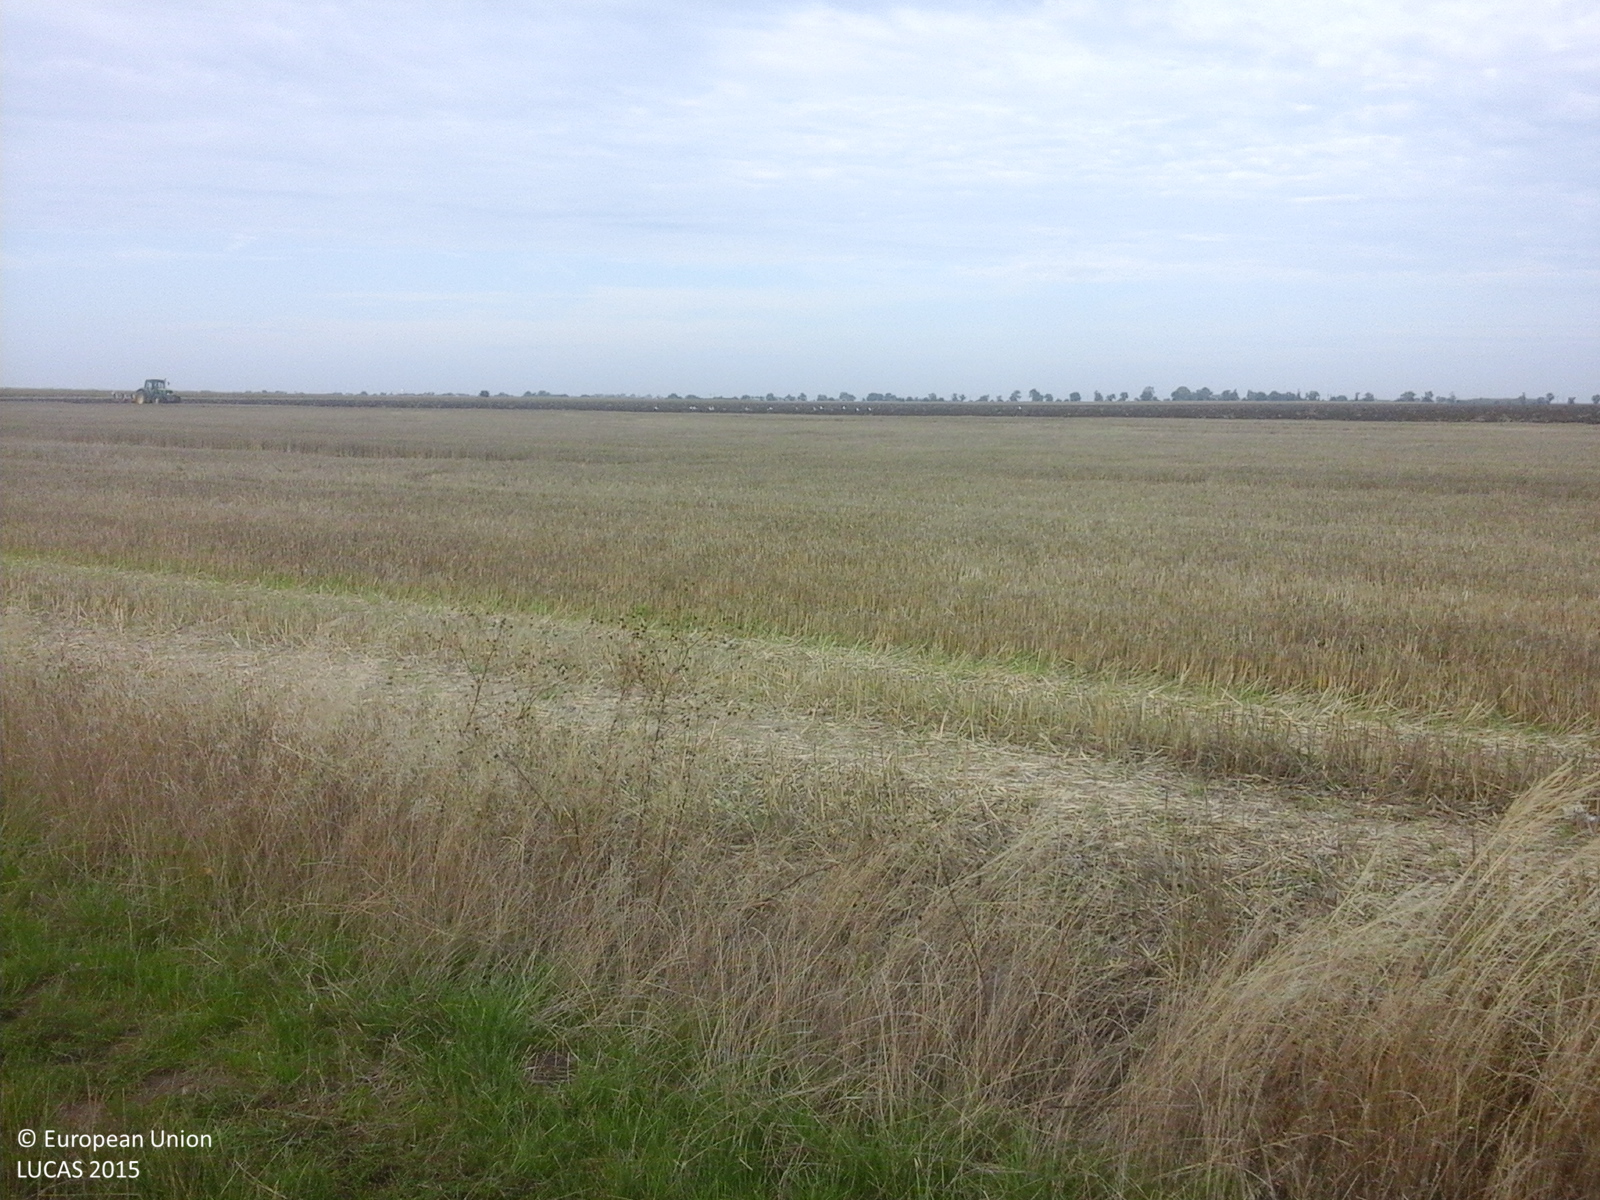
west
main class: Cropland
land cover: Soya
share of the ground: > 75 %
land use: Agriculture (excluding fallow land and kitchen gardens)
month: August
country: RO
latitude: 46.3009
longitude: 21.4218
